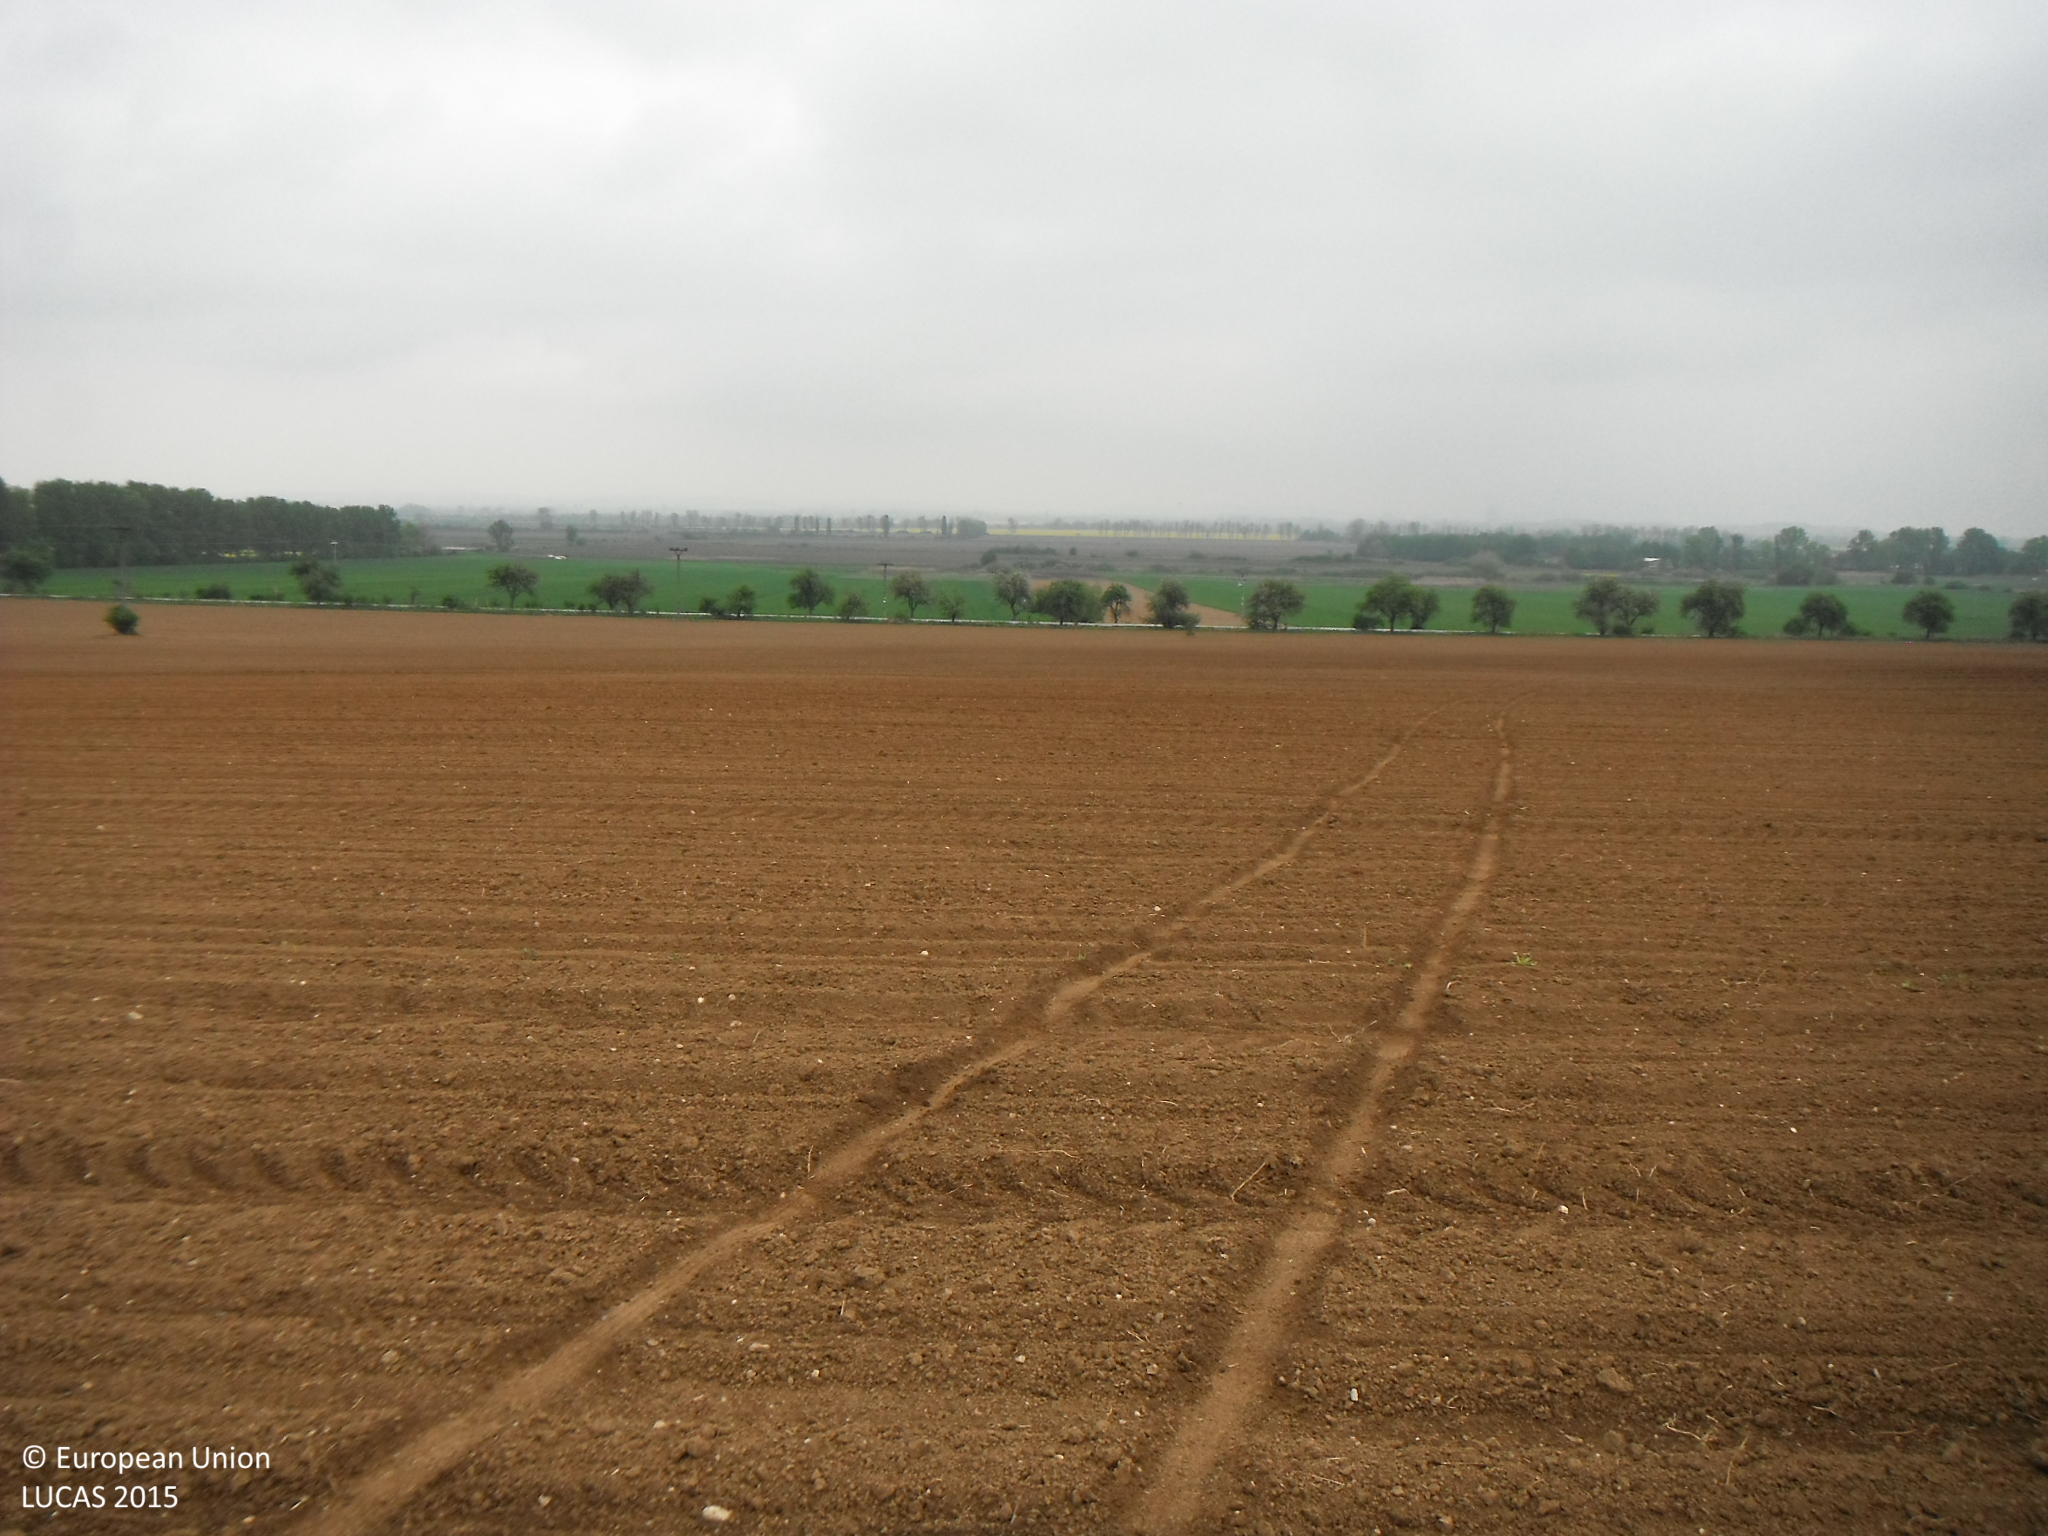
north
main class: Cropland
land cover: Maize
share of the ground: < 10 %
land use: Agriculture (excluding fallow land and kitchen gardens)
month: May
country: SK
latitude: 48.5295
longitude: 21.1329
